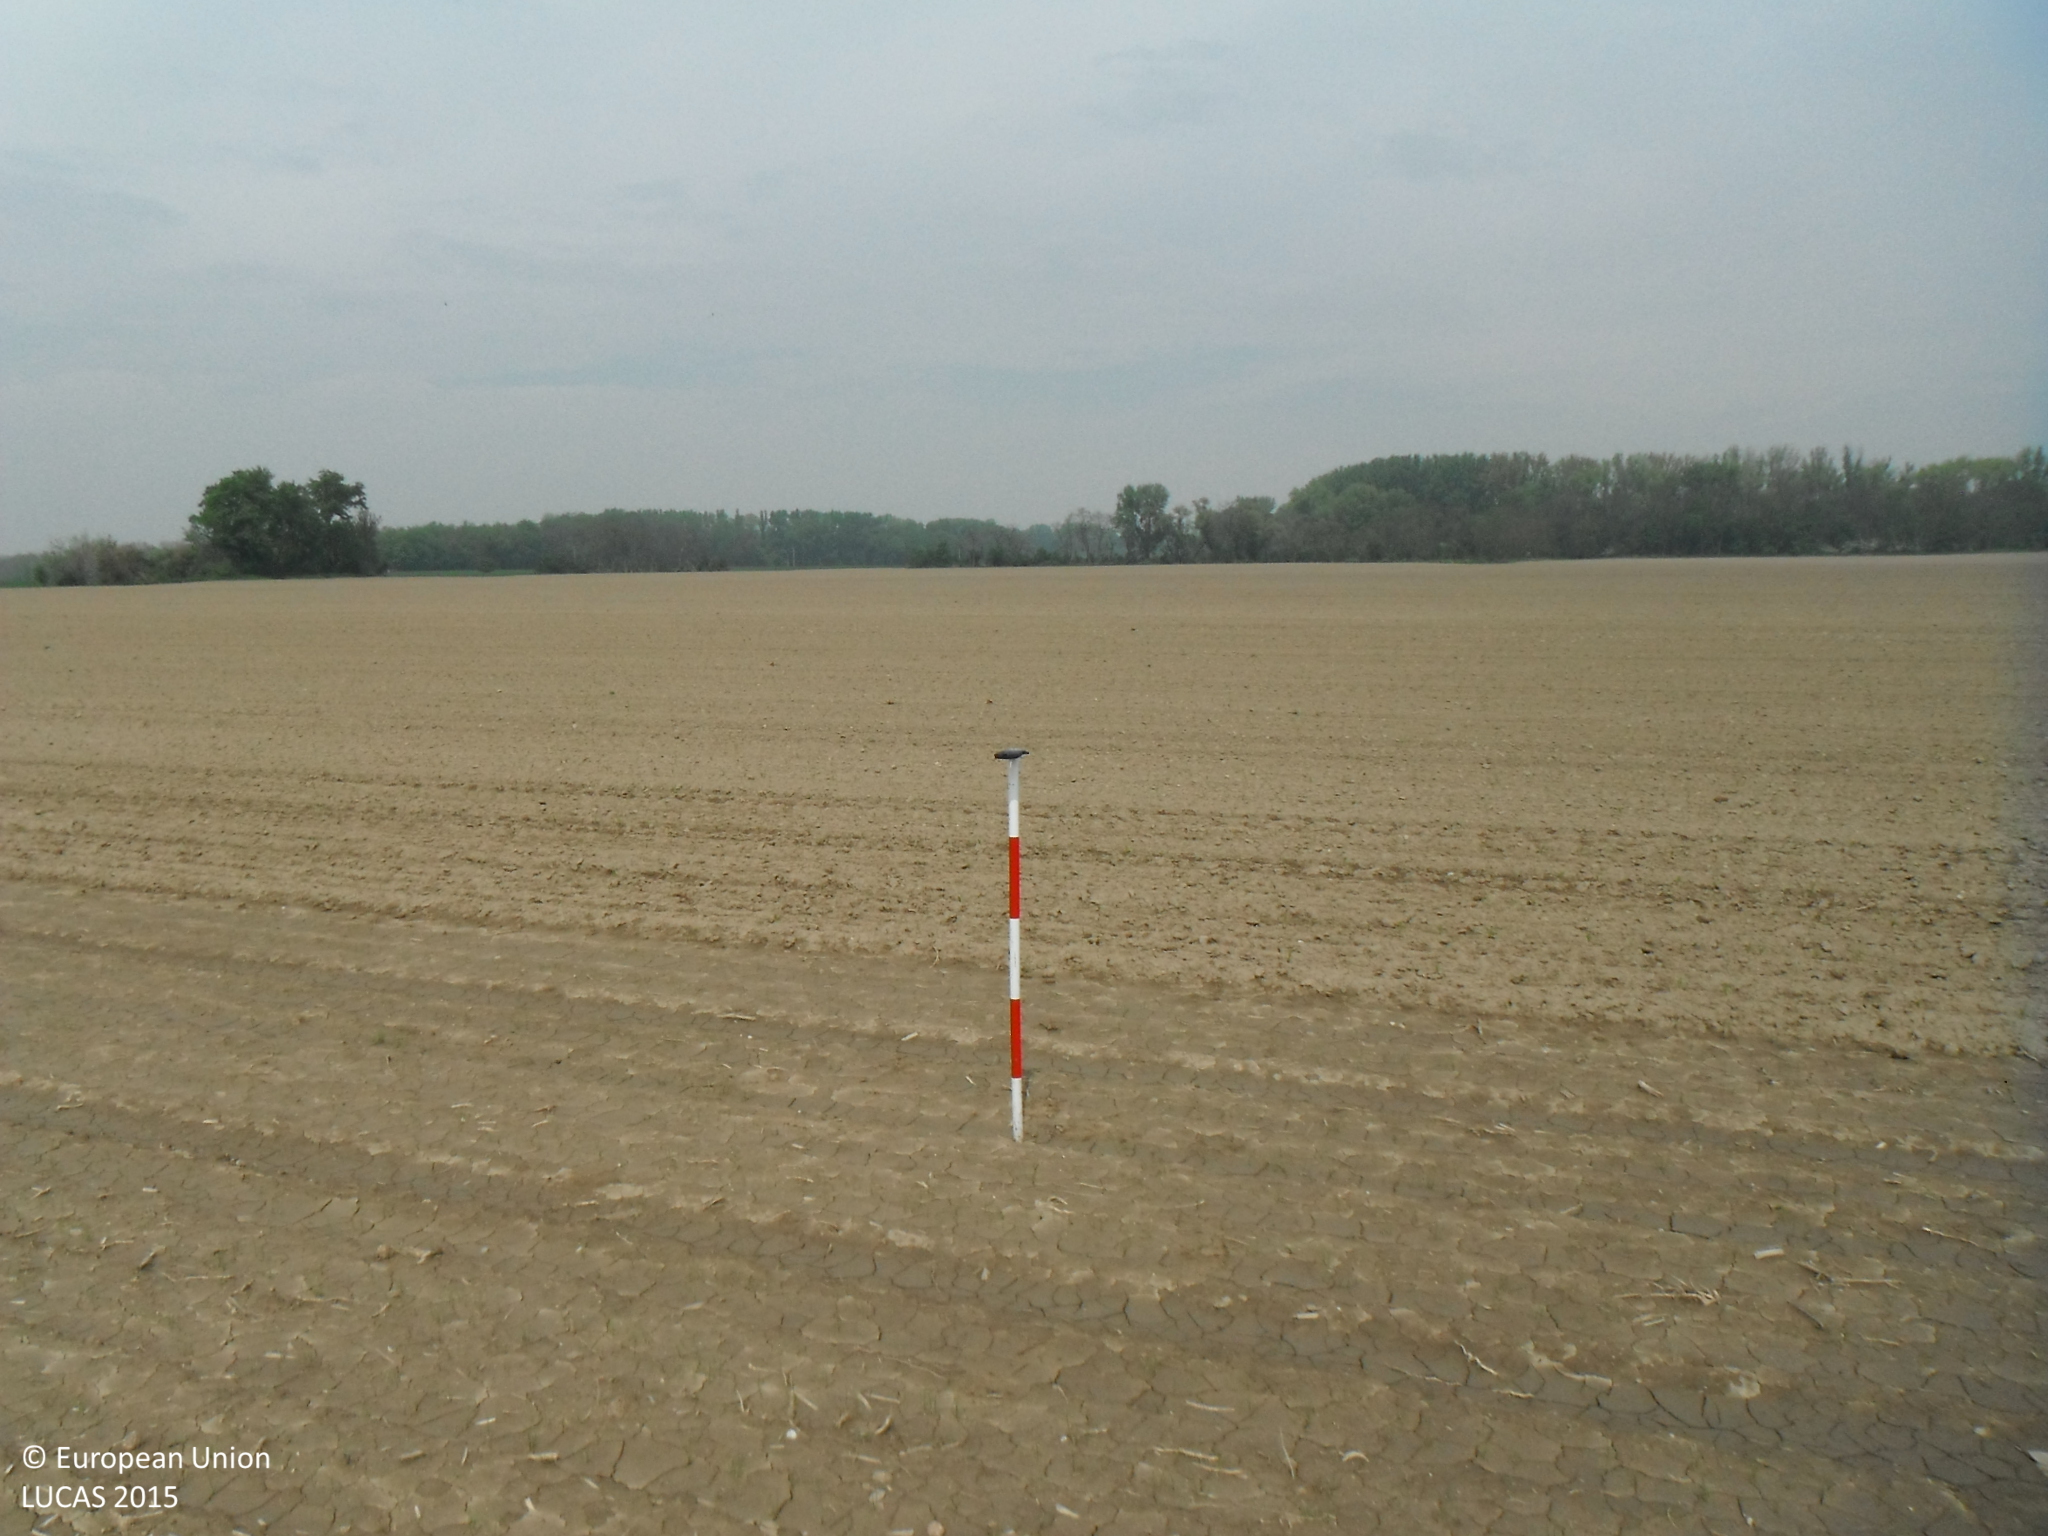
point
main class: Cropland
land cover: Other fresh vegetables
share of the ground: < 10 %
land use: Agriculture (excluding fallow land and kitchen gardens)
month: May
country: SK
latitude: 48.1561
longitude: 17.3896
